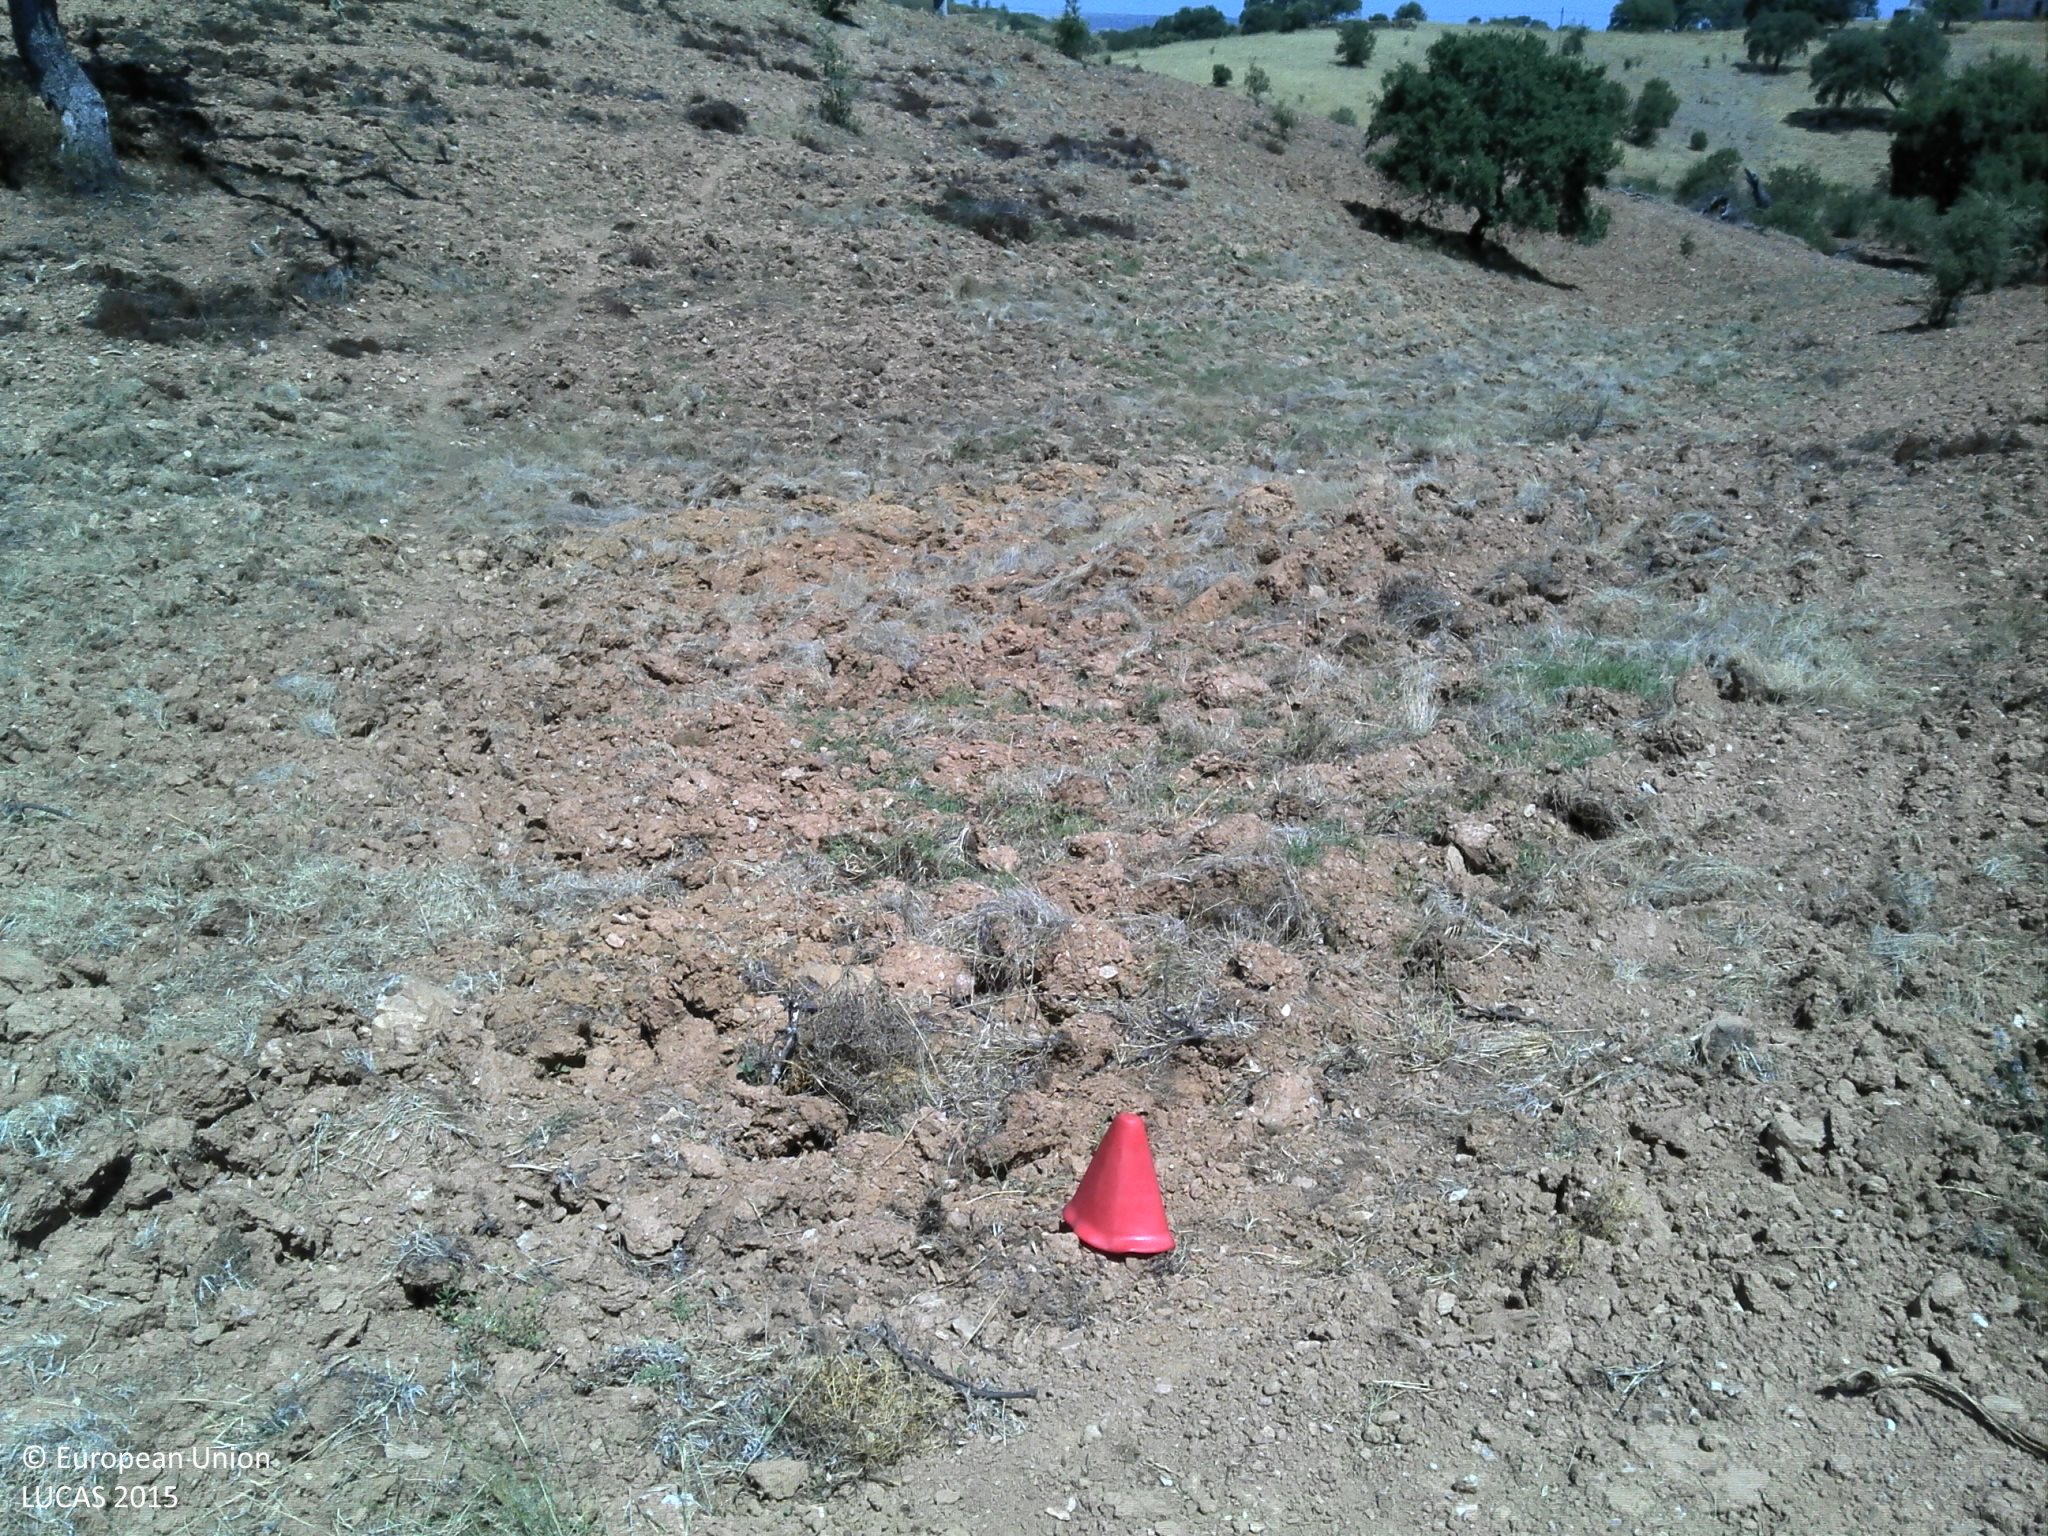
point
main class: Grassland
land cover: Grassland with sparse tree/shrub cover
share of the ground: 10 - 25 %
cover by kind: unconsolidated bare surface 75 %, herbaceous plants 20 %, broadleaved forest trees 5 %
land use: Agriculture (excluding fallow land and kitchen gardens)
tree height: < 5 m
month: June
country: PT
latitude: 37.8481
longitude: -7.5063
